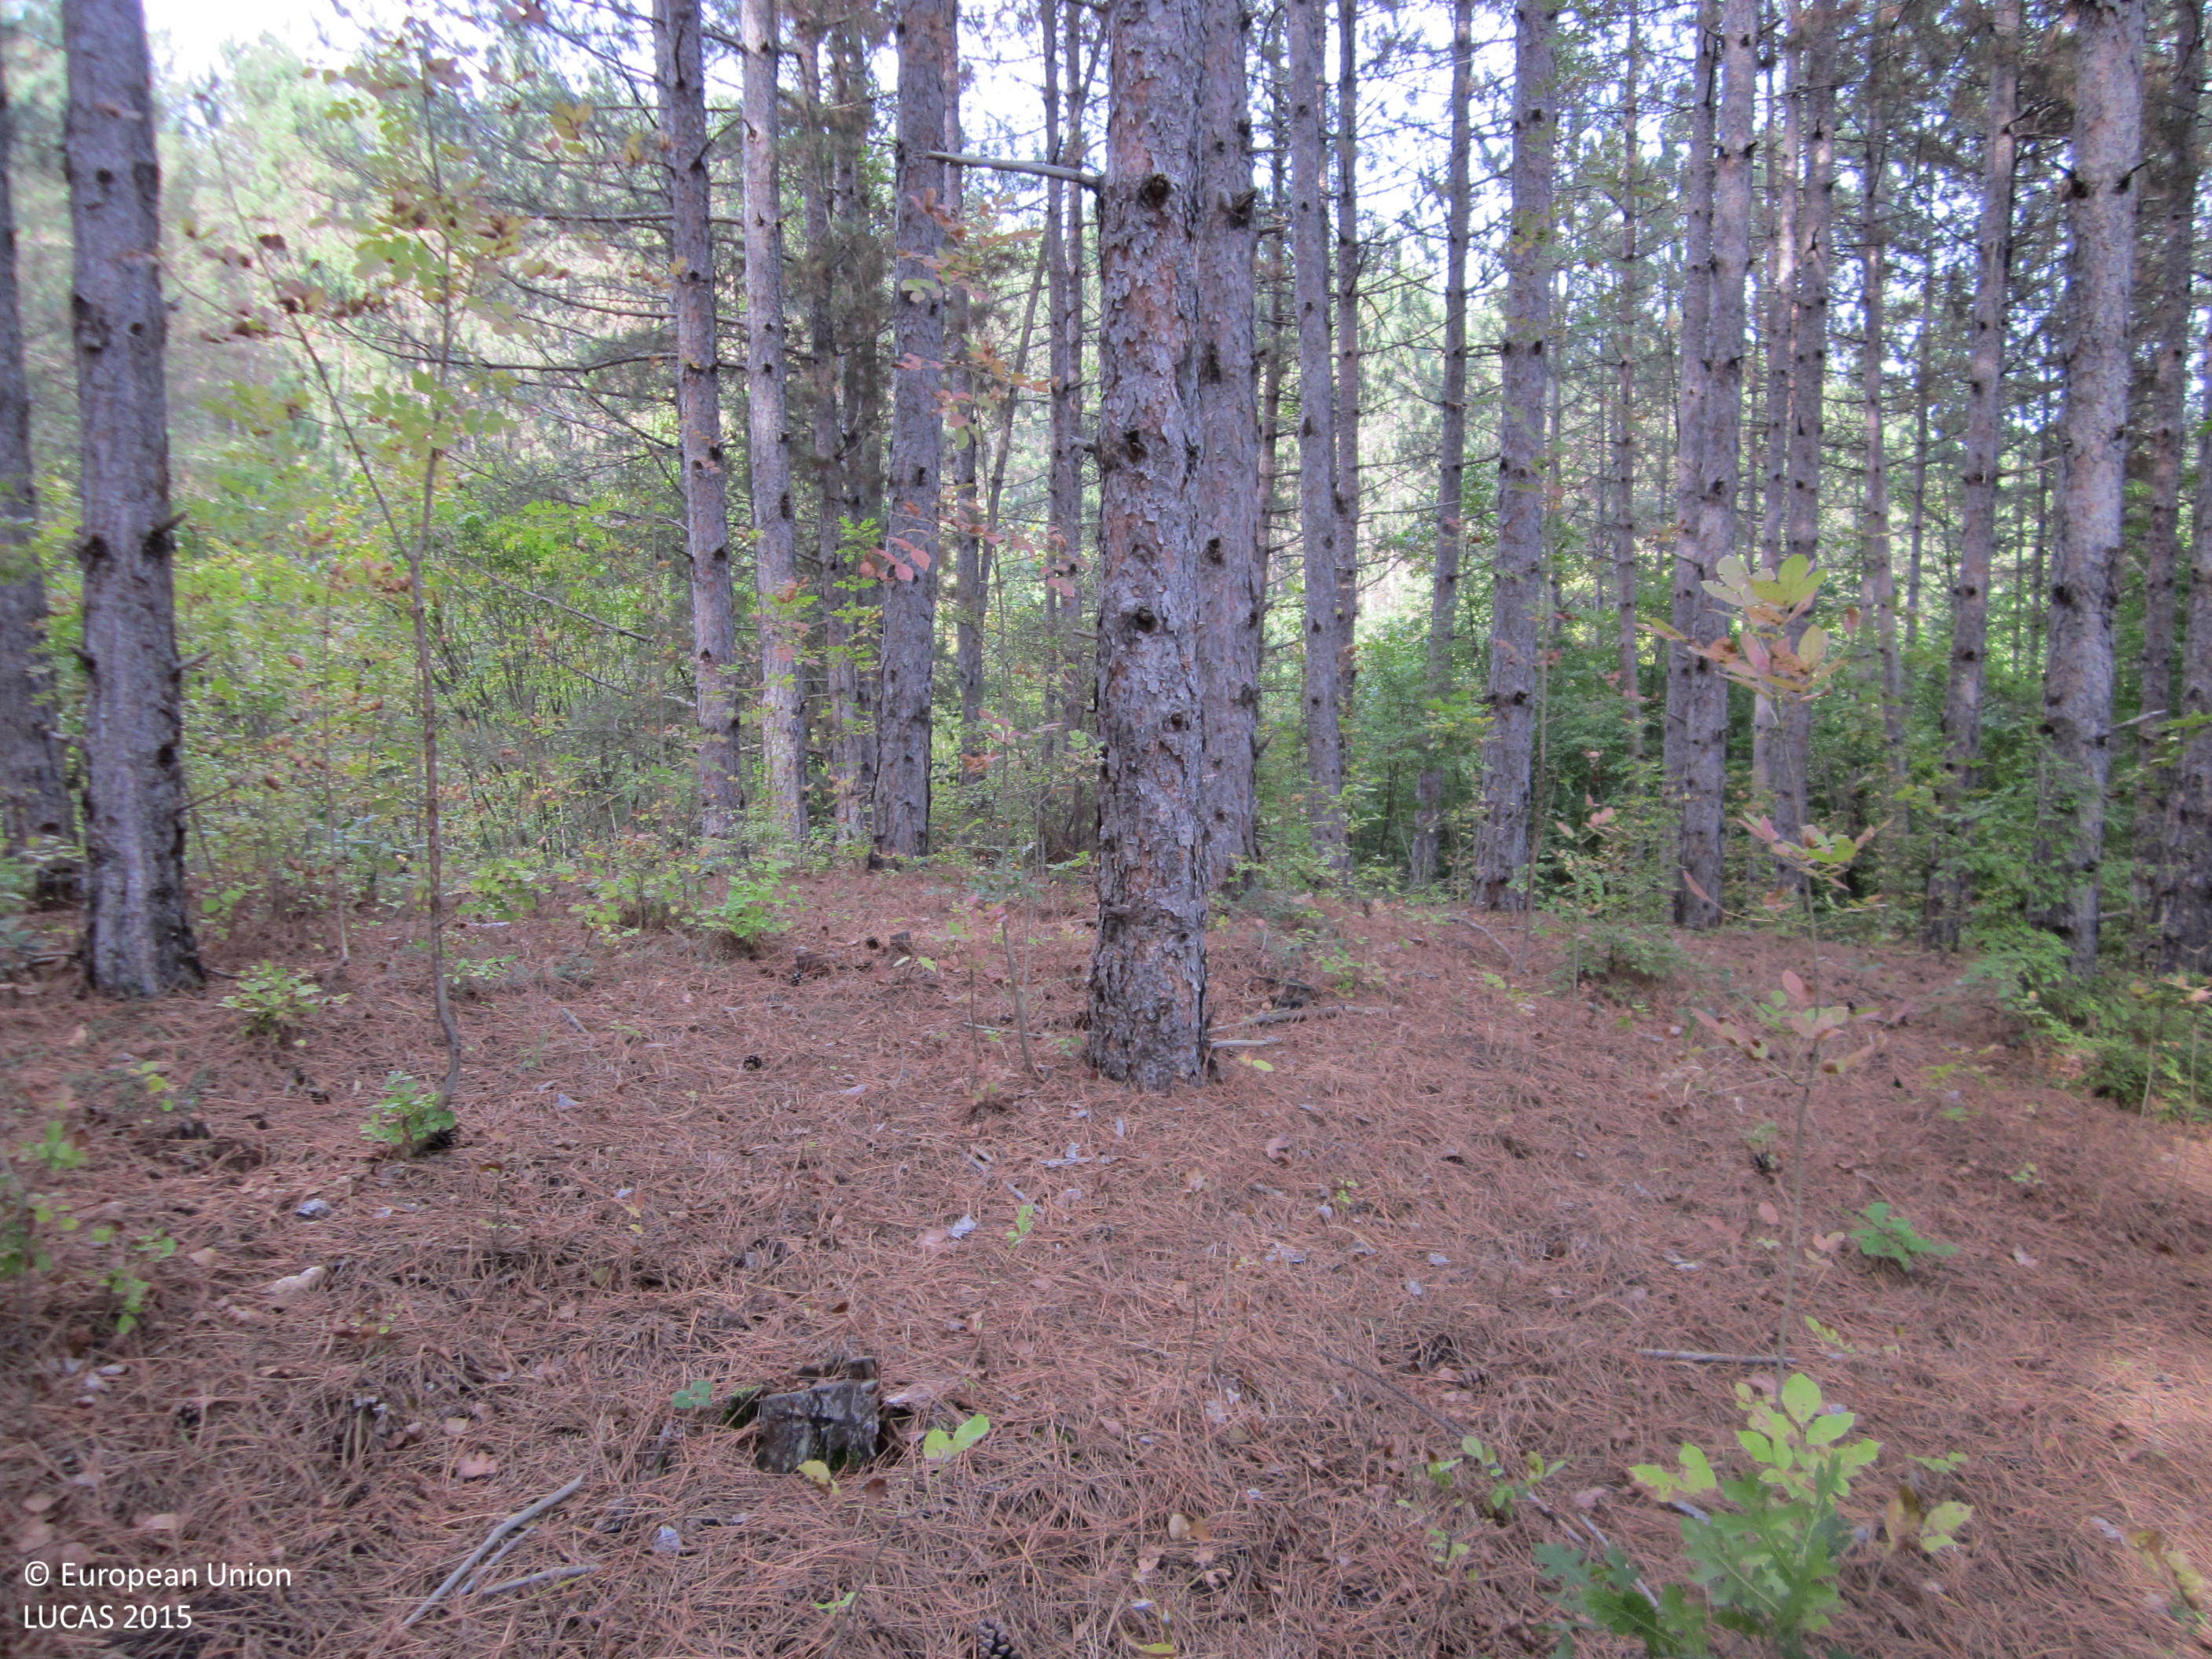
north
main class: Woodland
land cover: Pine dominated mixed woodland
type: hemiboreal forest and nemoral coniferous forest and mixed broadleaved-coniferous forest
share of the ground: > 75 %
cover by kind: coniferous forest trees 60 %, broadleaved forest trees 20 %, unconsolidated bare surface 15 %, herbaceous plants 5 %
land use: Forestry
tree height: > 5 m
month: October
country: BG
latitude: 42.8488
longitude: 26.8577
